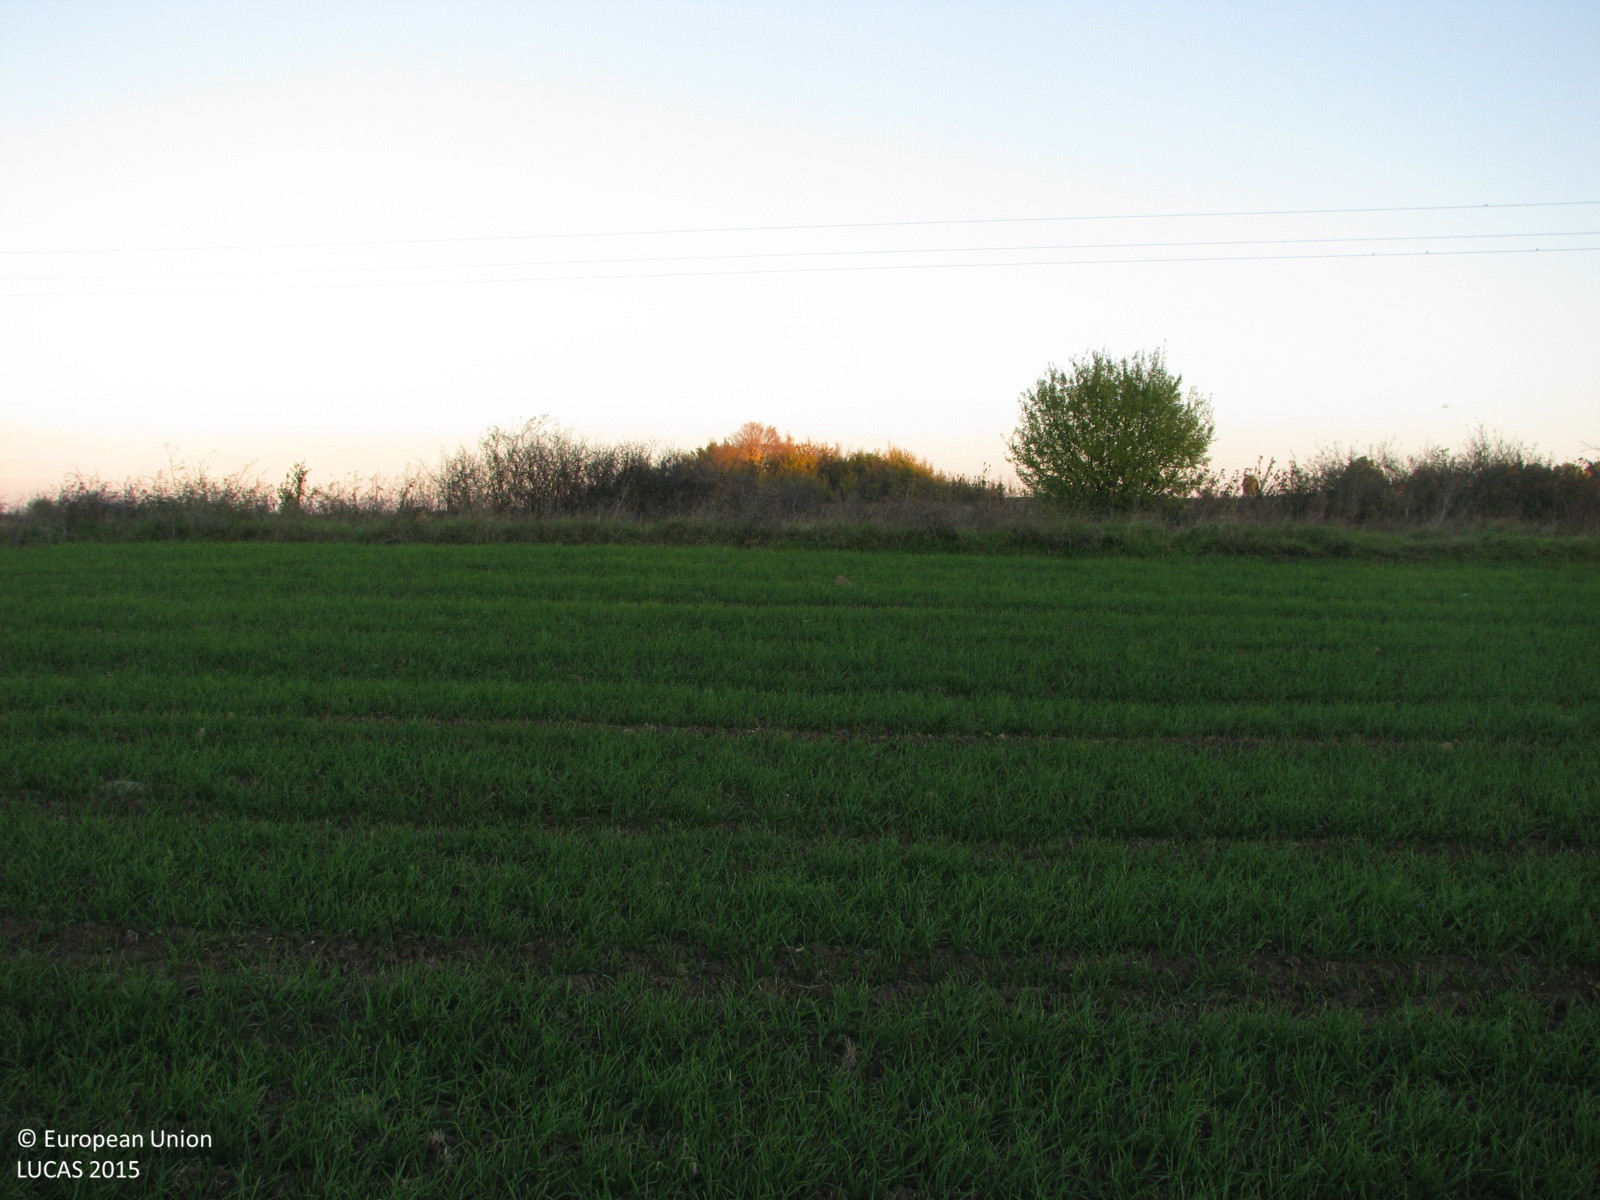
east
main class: Cropland
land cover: Common wheat
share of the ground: > 75 %
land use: Agriculture (excluding fallow land and kitchen gardens)
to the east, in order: Common wheat; Grass margins; Paved roads, cycling and walking lanes; Grass margins; Ditches and canals; Shrubland without tree cover; Sunflower; Electric lines; Sunflower; Grassland without tree/shrub cover
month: November
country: BG
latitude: 42.0795
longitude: 26.8365
